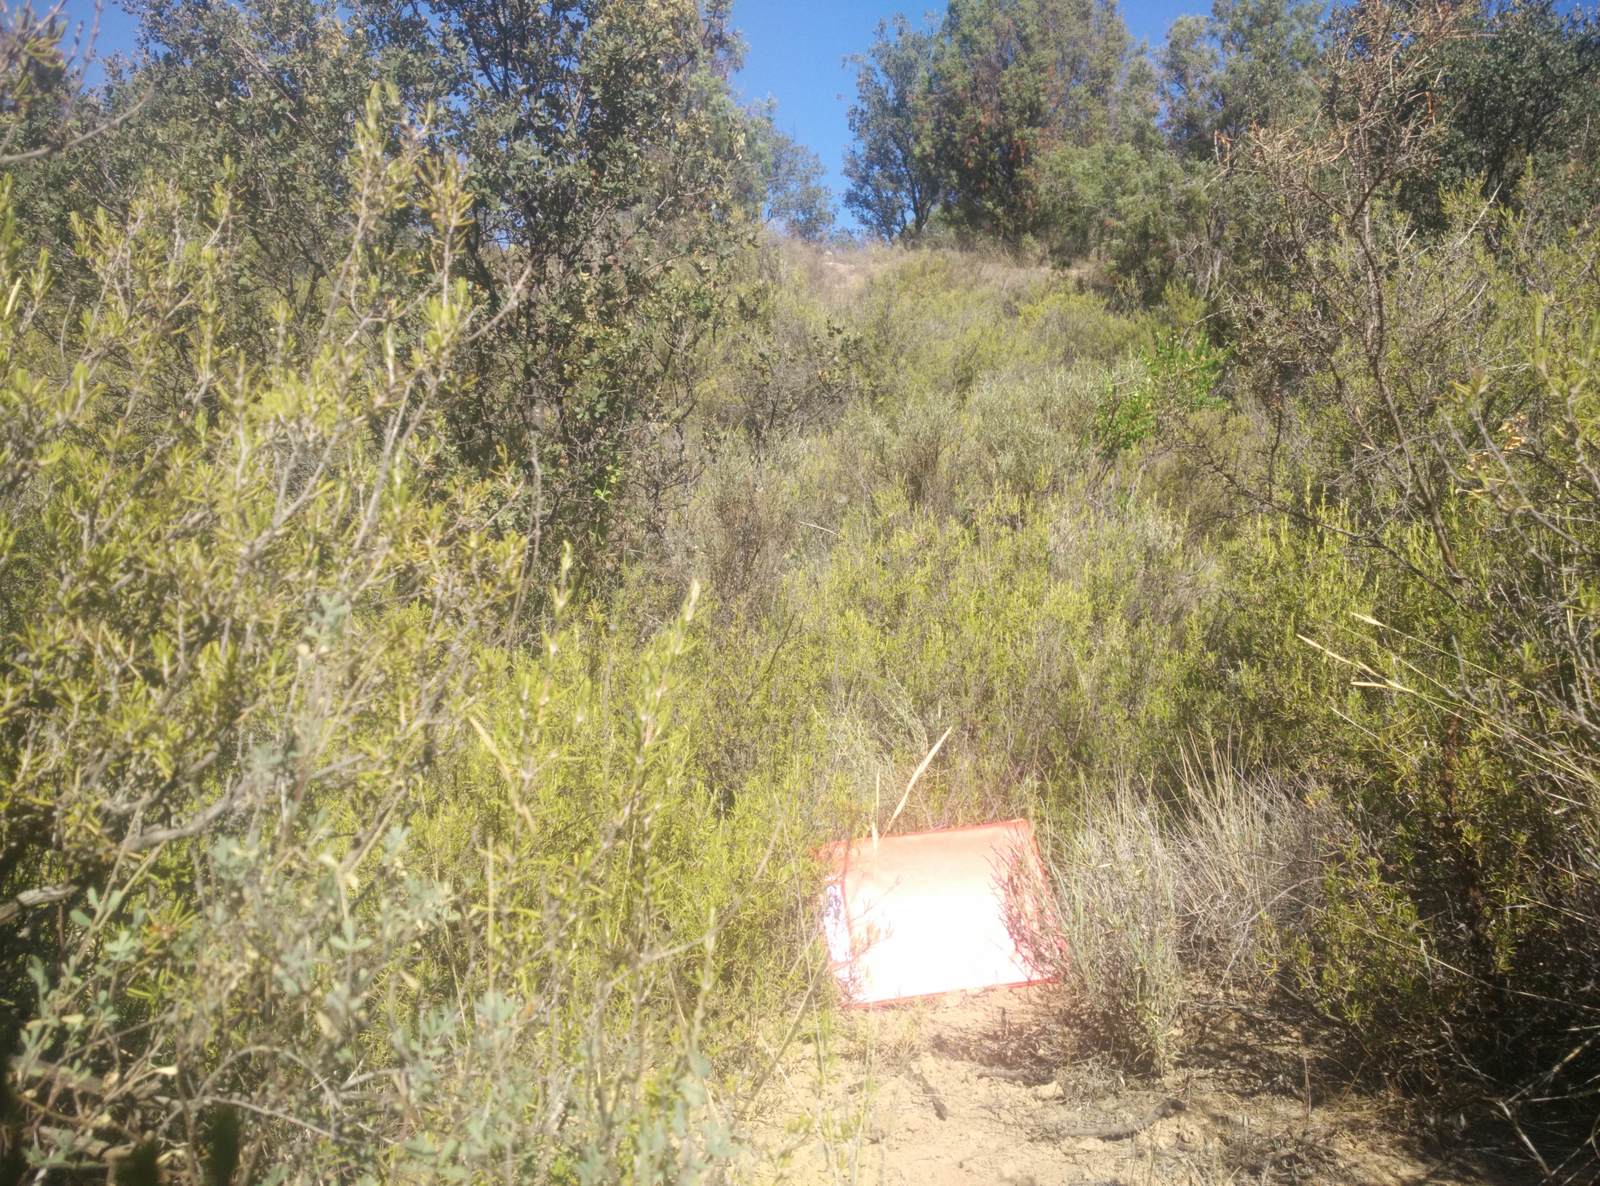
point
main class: Cropland
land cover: Olive groves
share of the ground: 10 - 25 %
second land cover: Shrubland without tree cover
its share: 50 - 75 %
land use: Agriculture (excluding fallow land and kitchen gardens)
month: July
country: ES
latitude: 40.7378
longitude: -2.8316
